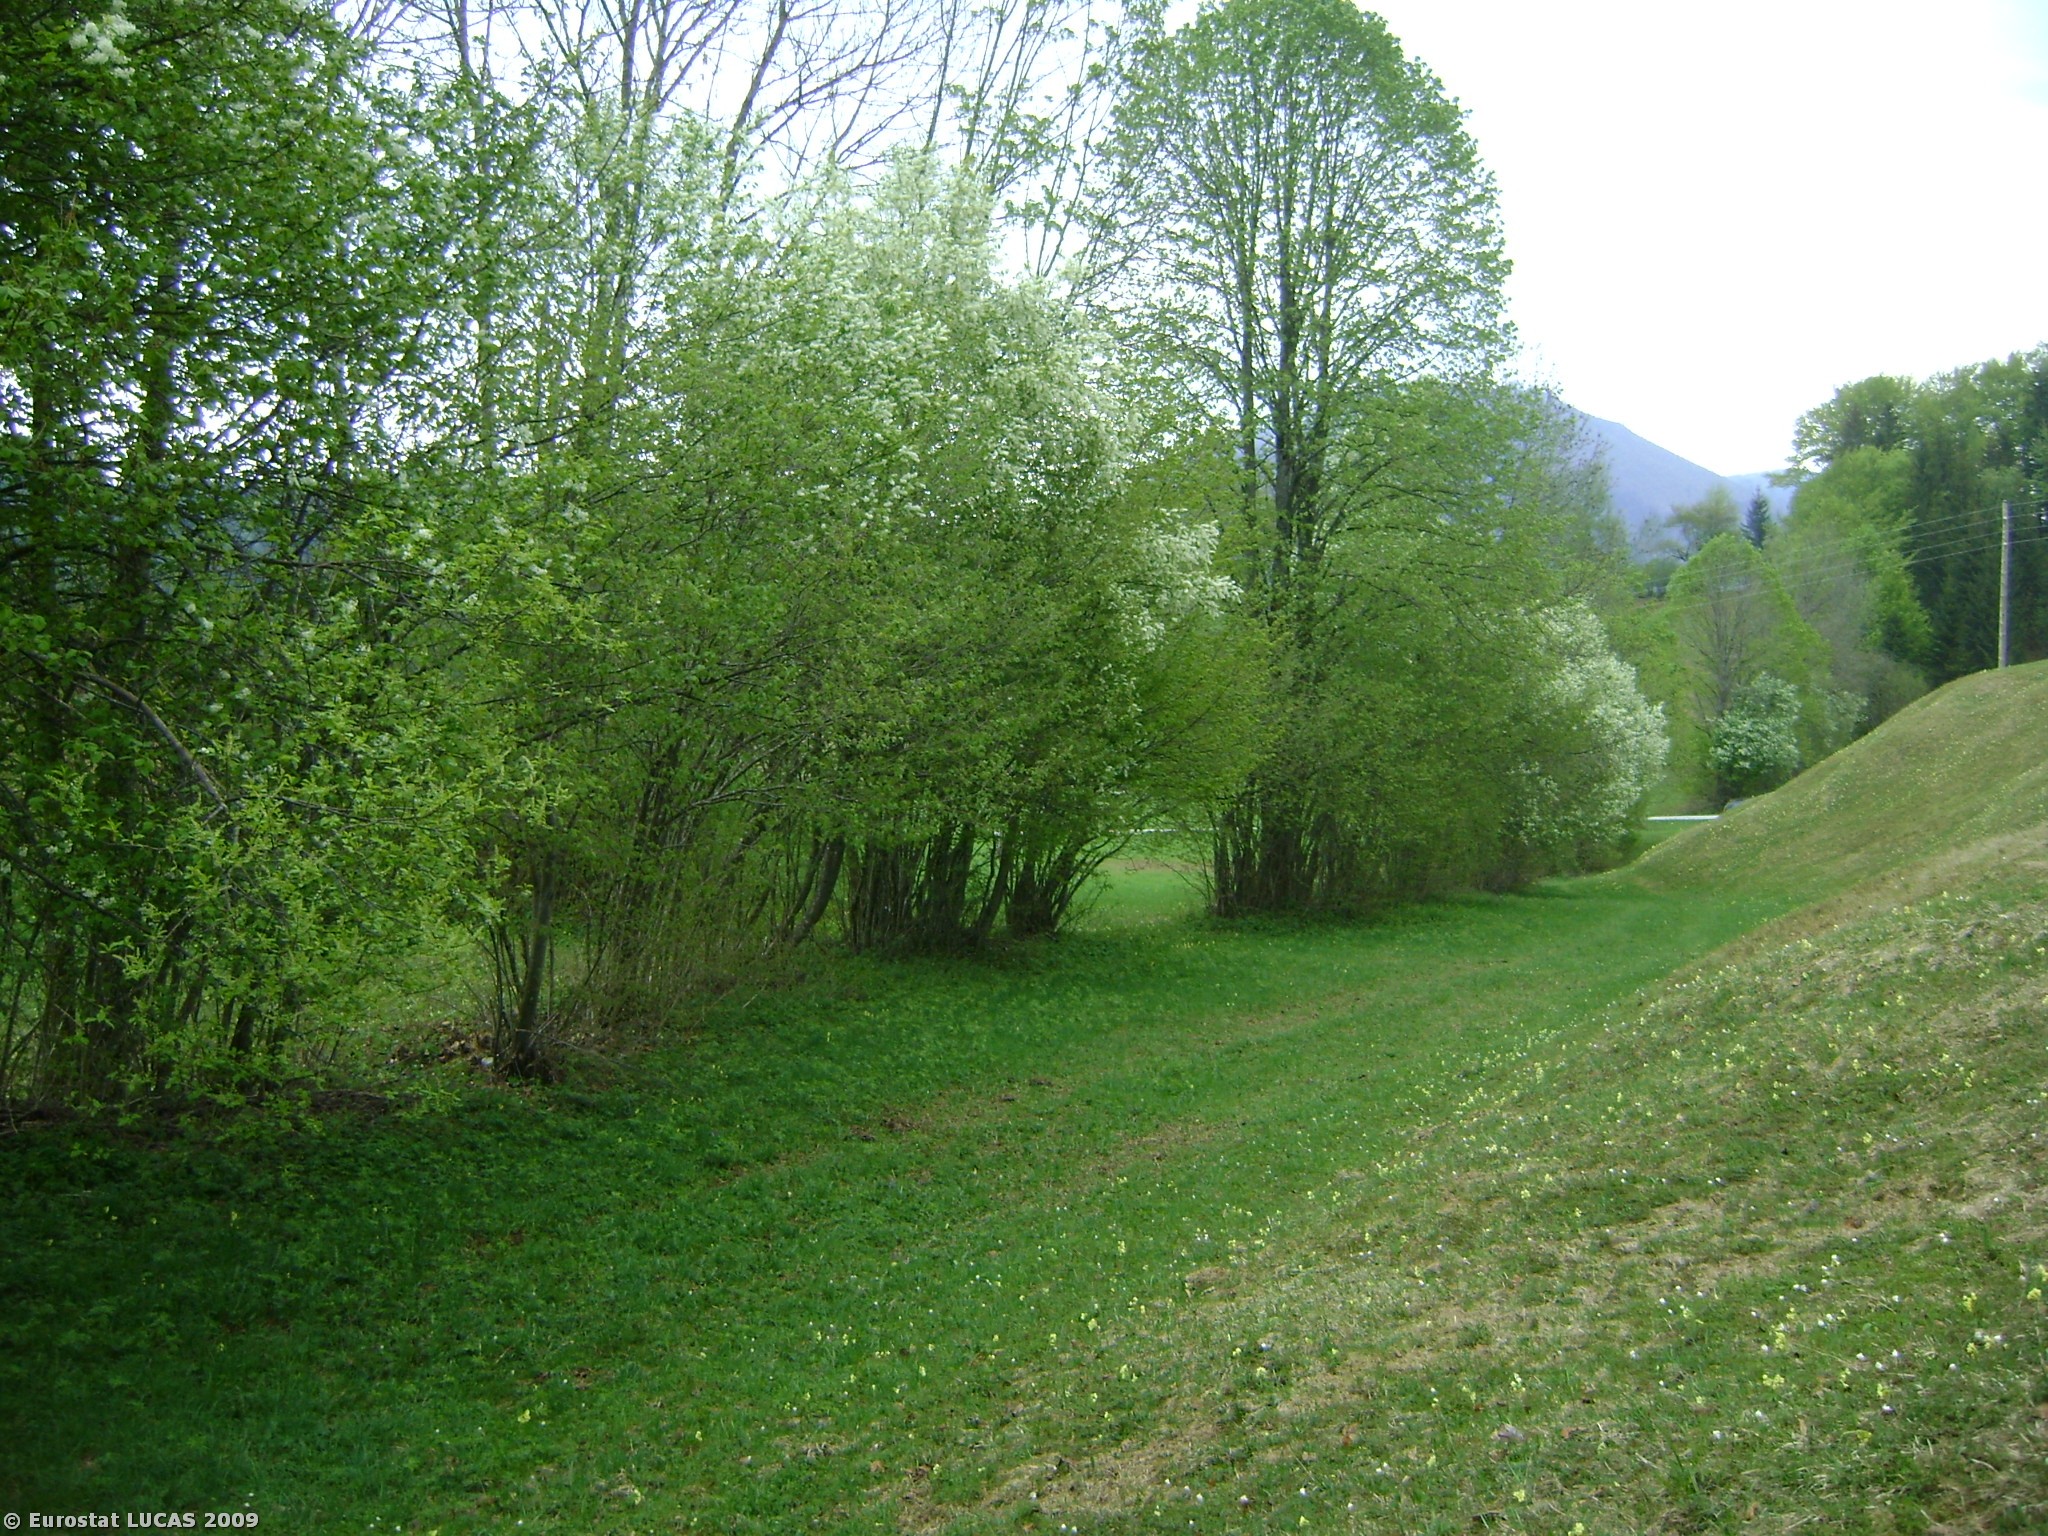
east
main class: Grassland
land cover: Grassland without tree/shrub cover
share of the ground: > 75 %
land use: Agriculture (excluding fallow land and kitchen gardens)
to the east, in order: Grassland without tree/shrub cover; Broadleaved woodland; Grassland without tree/shrub cover; Electric lines; Grassland without tree/shrub cover; Electric lines; Grassland without tree/shrub cover; Paved roads, cycling and walking lanes; Grassland without tree/shrub cover; Single bushes/trees; Grassland without tree/shrub cover
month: May
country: AT
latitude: 47.7625
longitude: 13.2140
